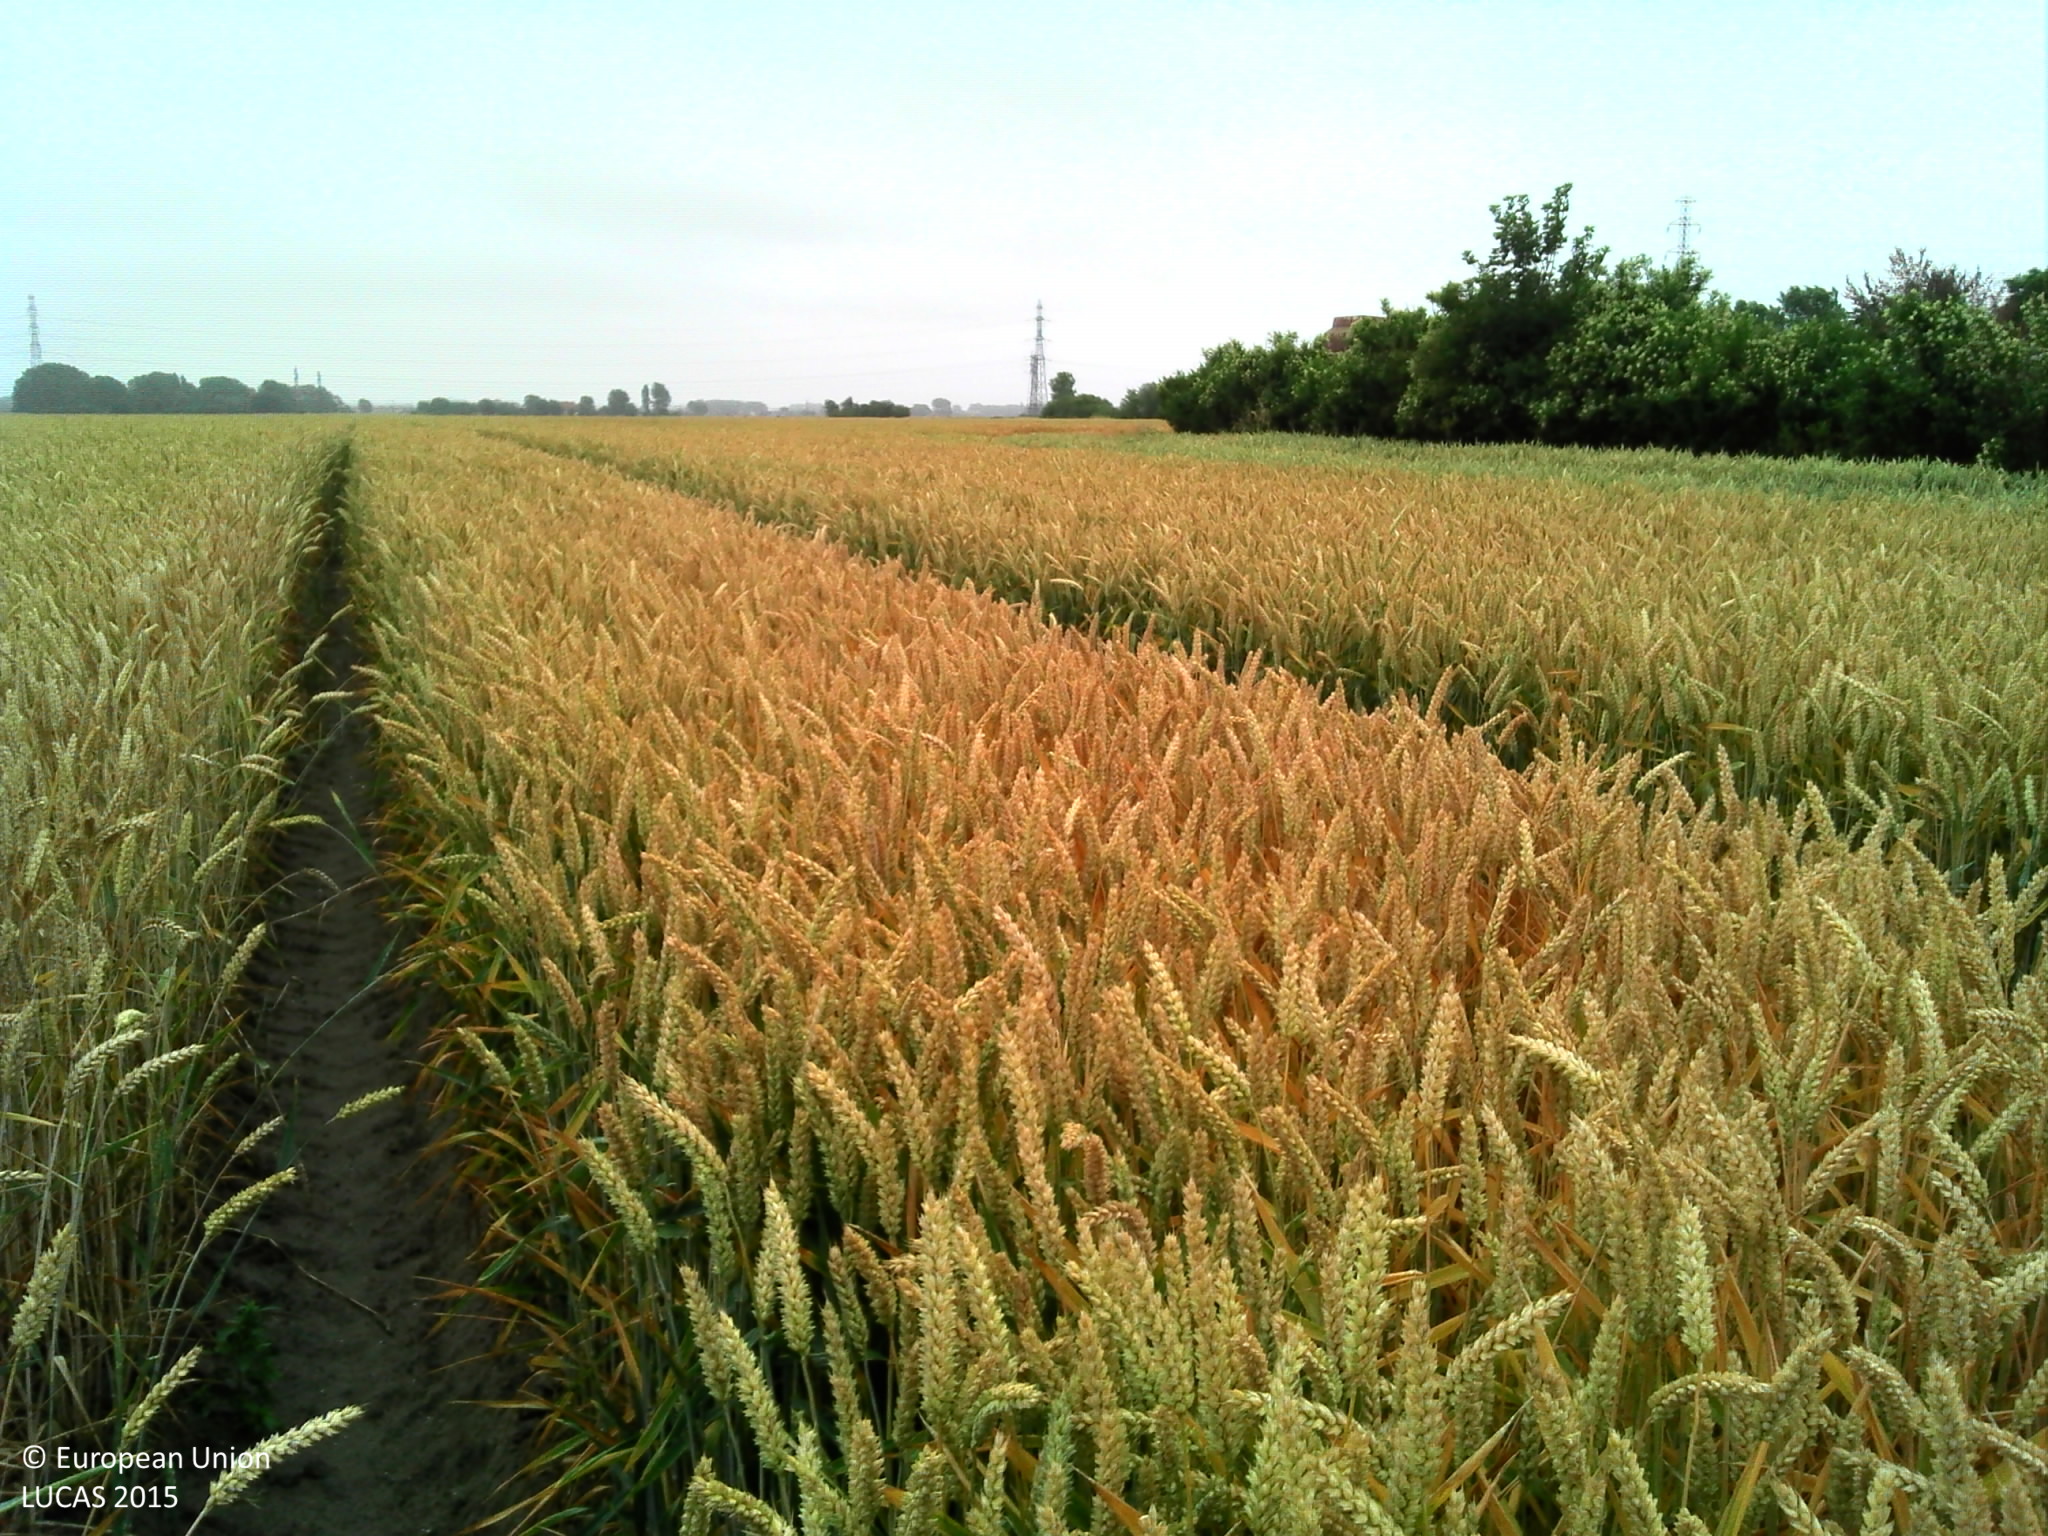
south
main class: Cropland
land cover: Common wheat
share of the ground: > 75 %
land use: Agriculture (excluding fallow land and kitchen gardens)
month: July
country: FR
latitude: 50.9899
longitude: 2.3071
